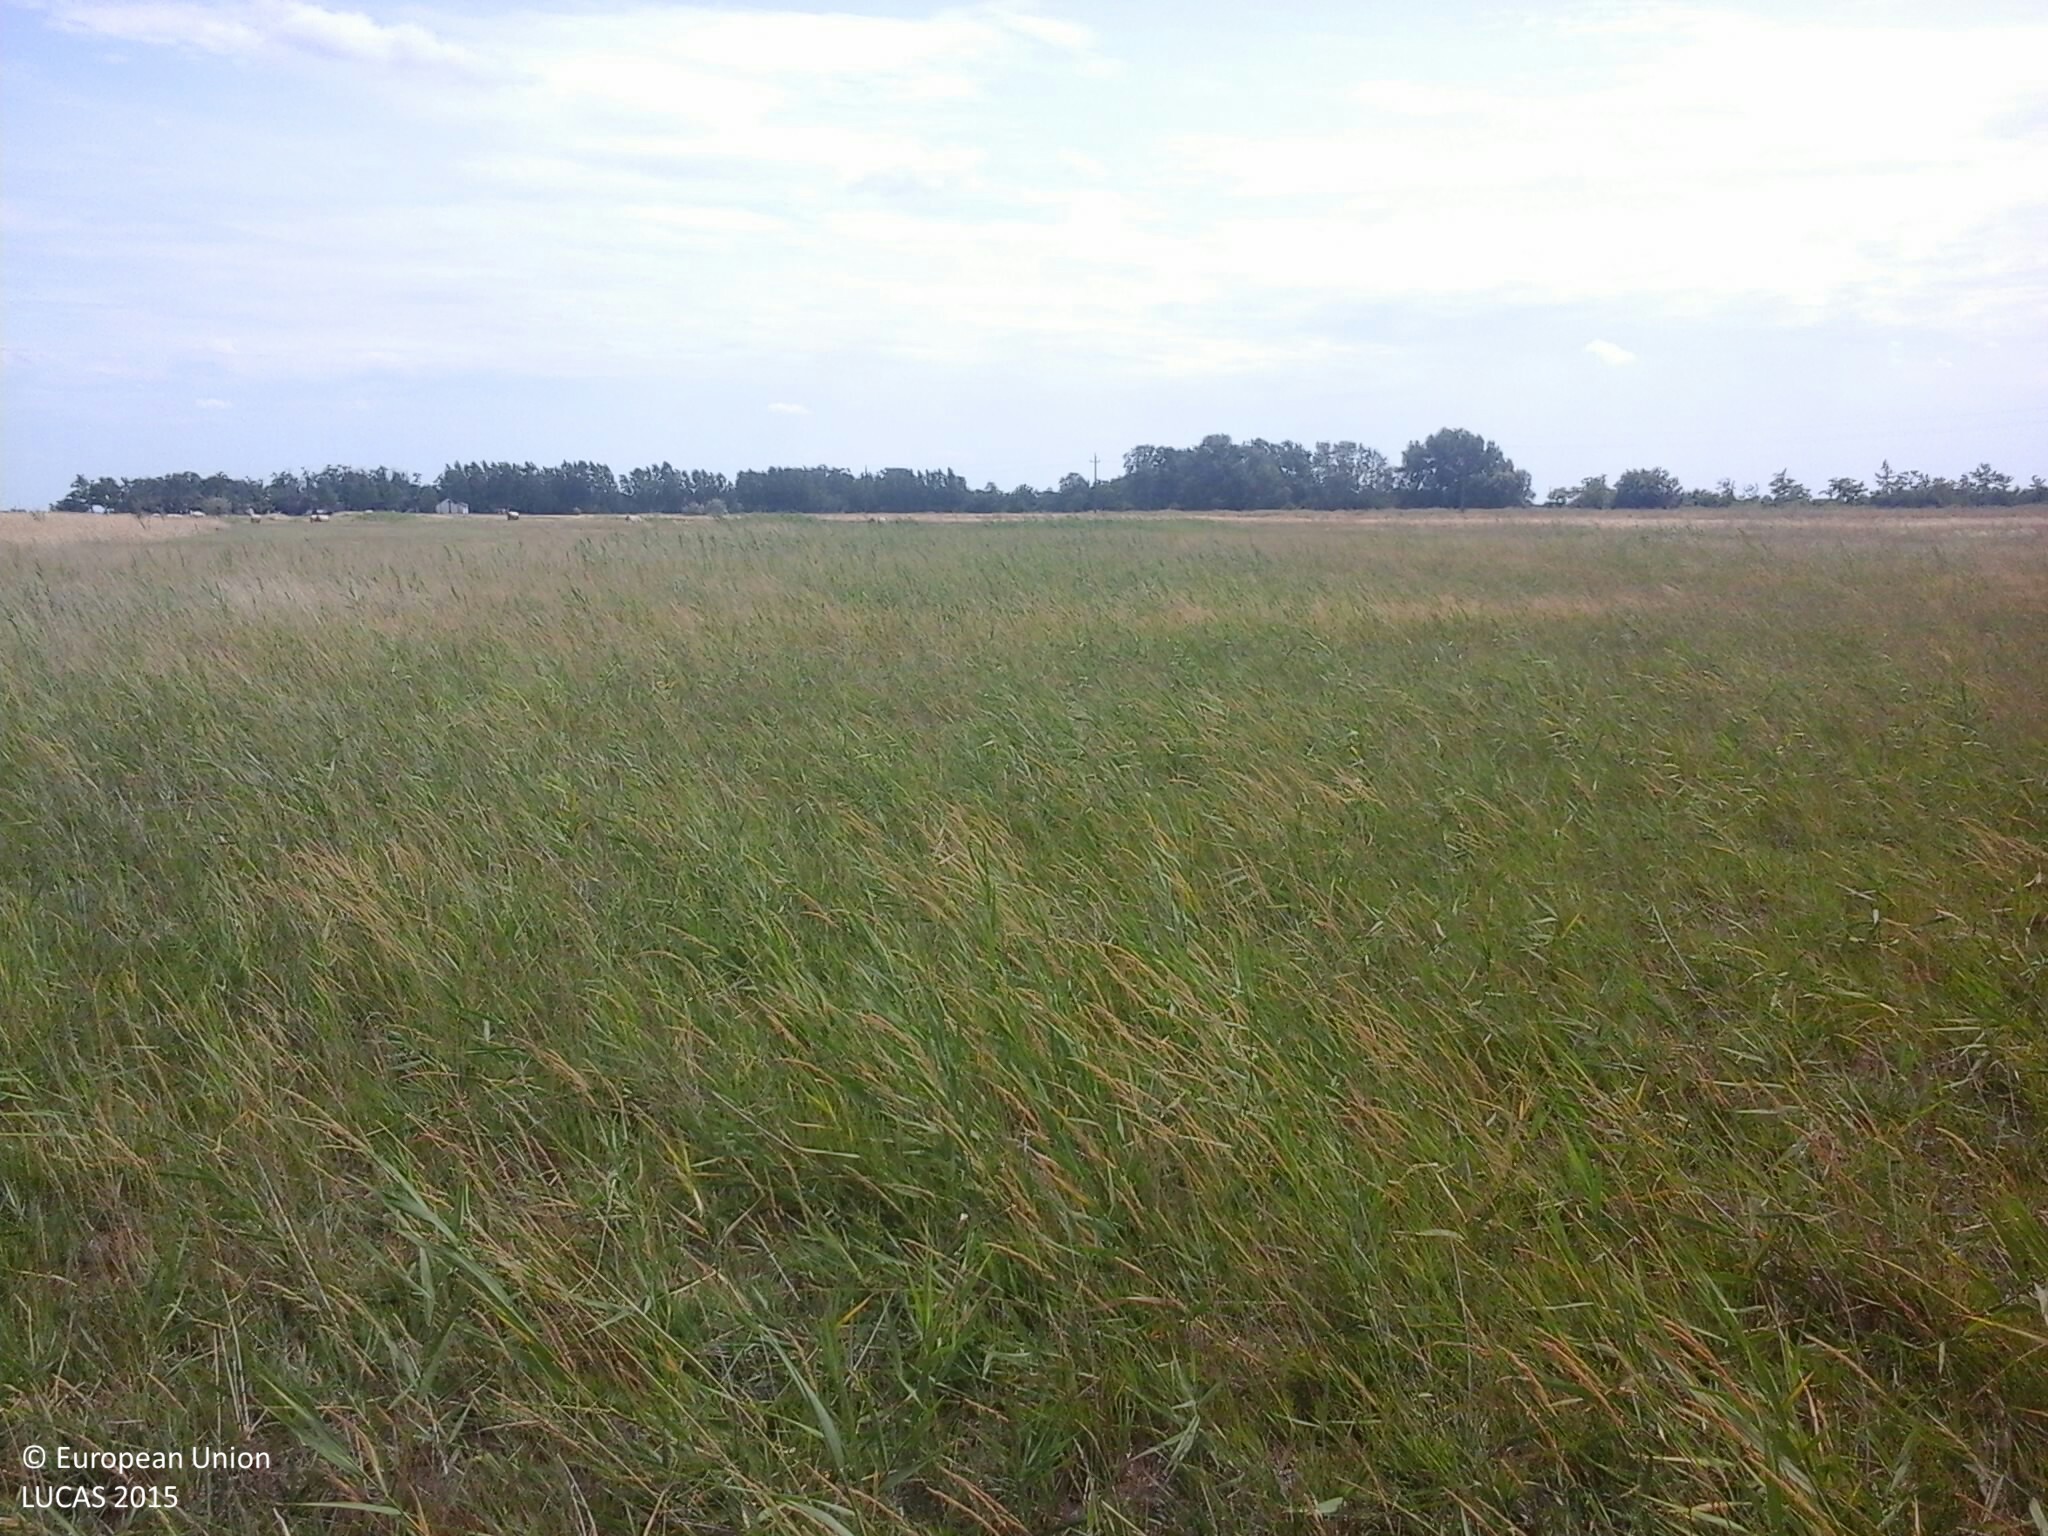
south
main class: Grassland
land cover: Spontaneously vegetated surfaces
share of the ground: > 75 %
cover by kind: herbaceous plants 90 %, consolidated bare surface 10 %
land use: Agriculture (excluding fallow land and kitchen gardens)
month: July
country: HU
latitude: 47.1044
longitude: 19.0955
